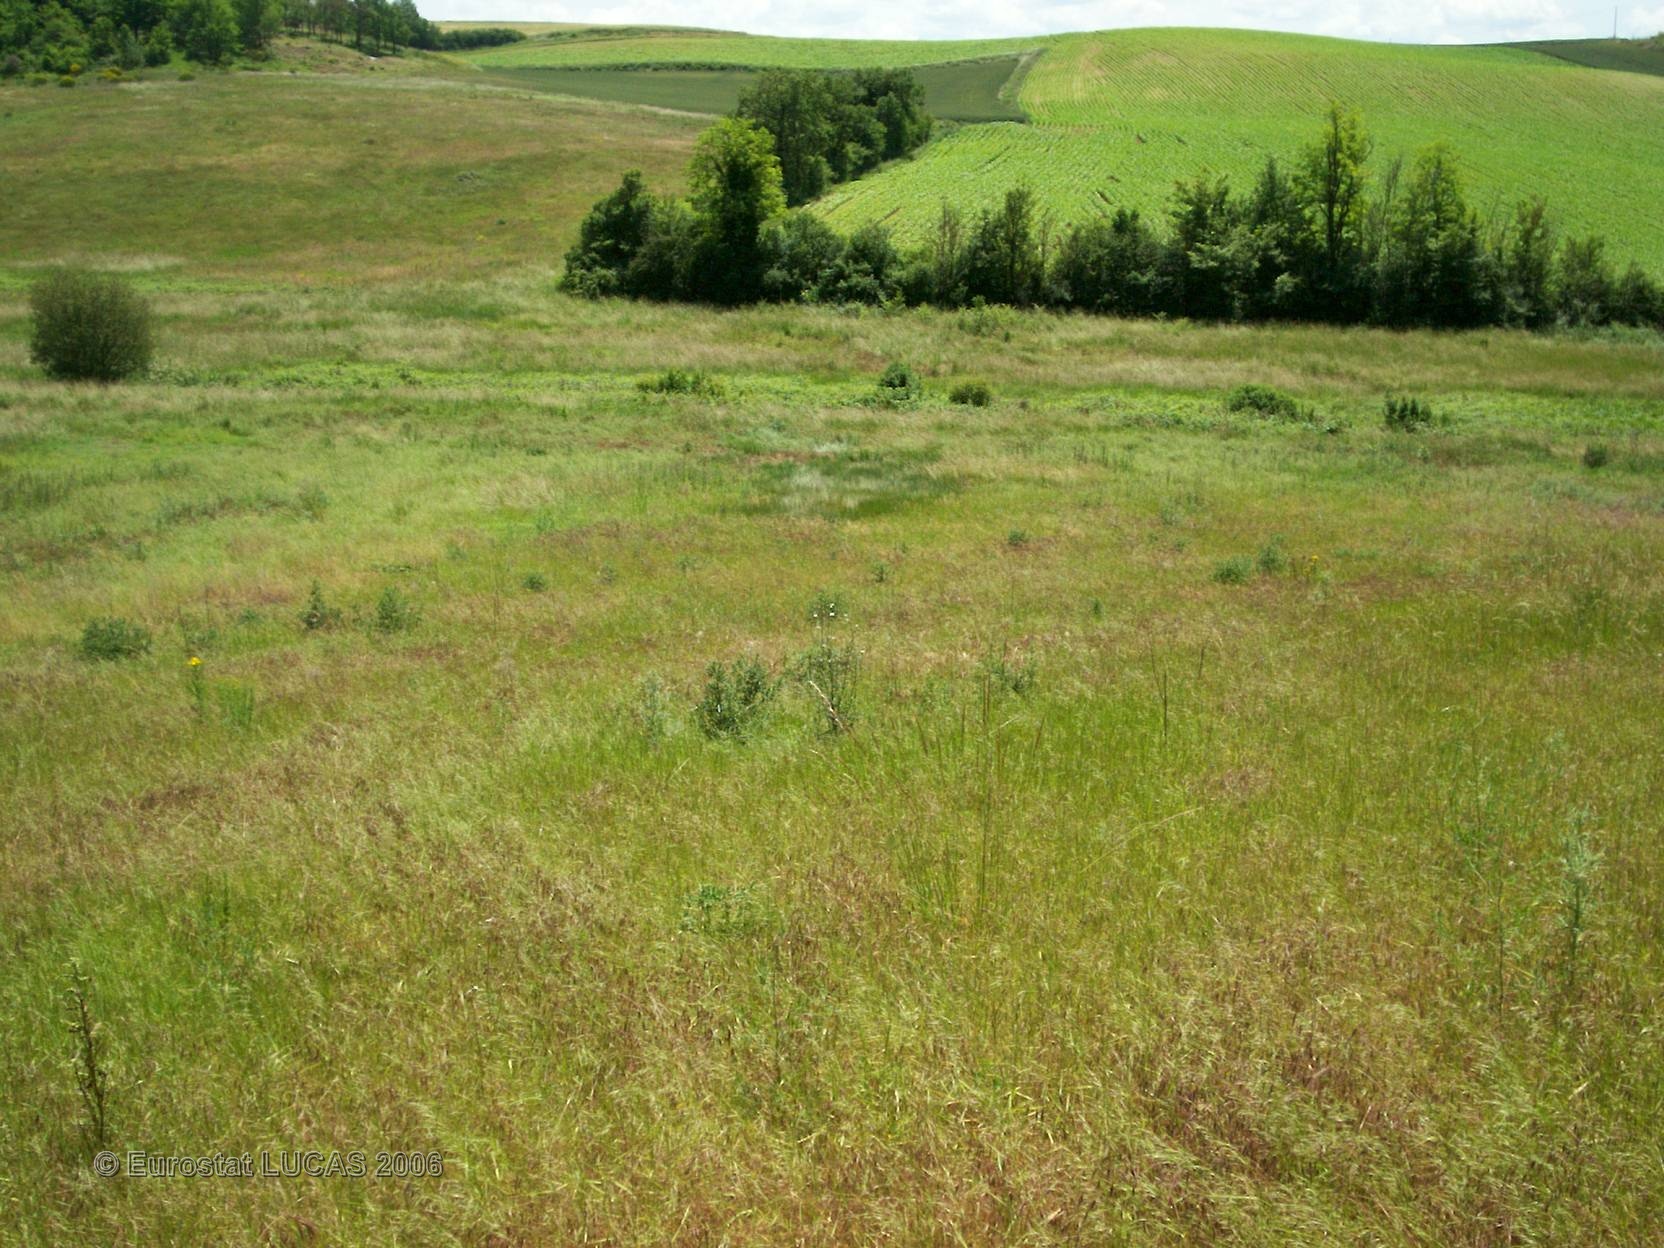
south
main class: Grassland
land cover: Grassland without tree/shrub cover
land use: Agriculture (excluding fallow land and kitchen gardens)
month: May
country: FR
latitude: 43.4502
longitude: 0.9927
